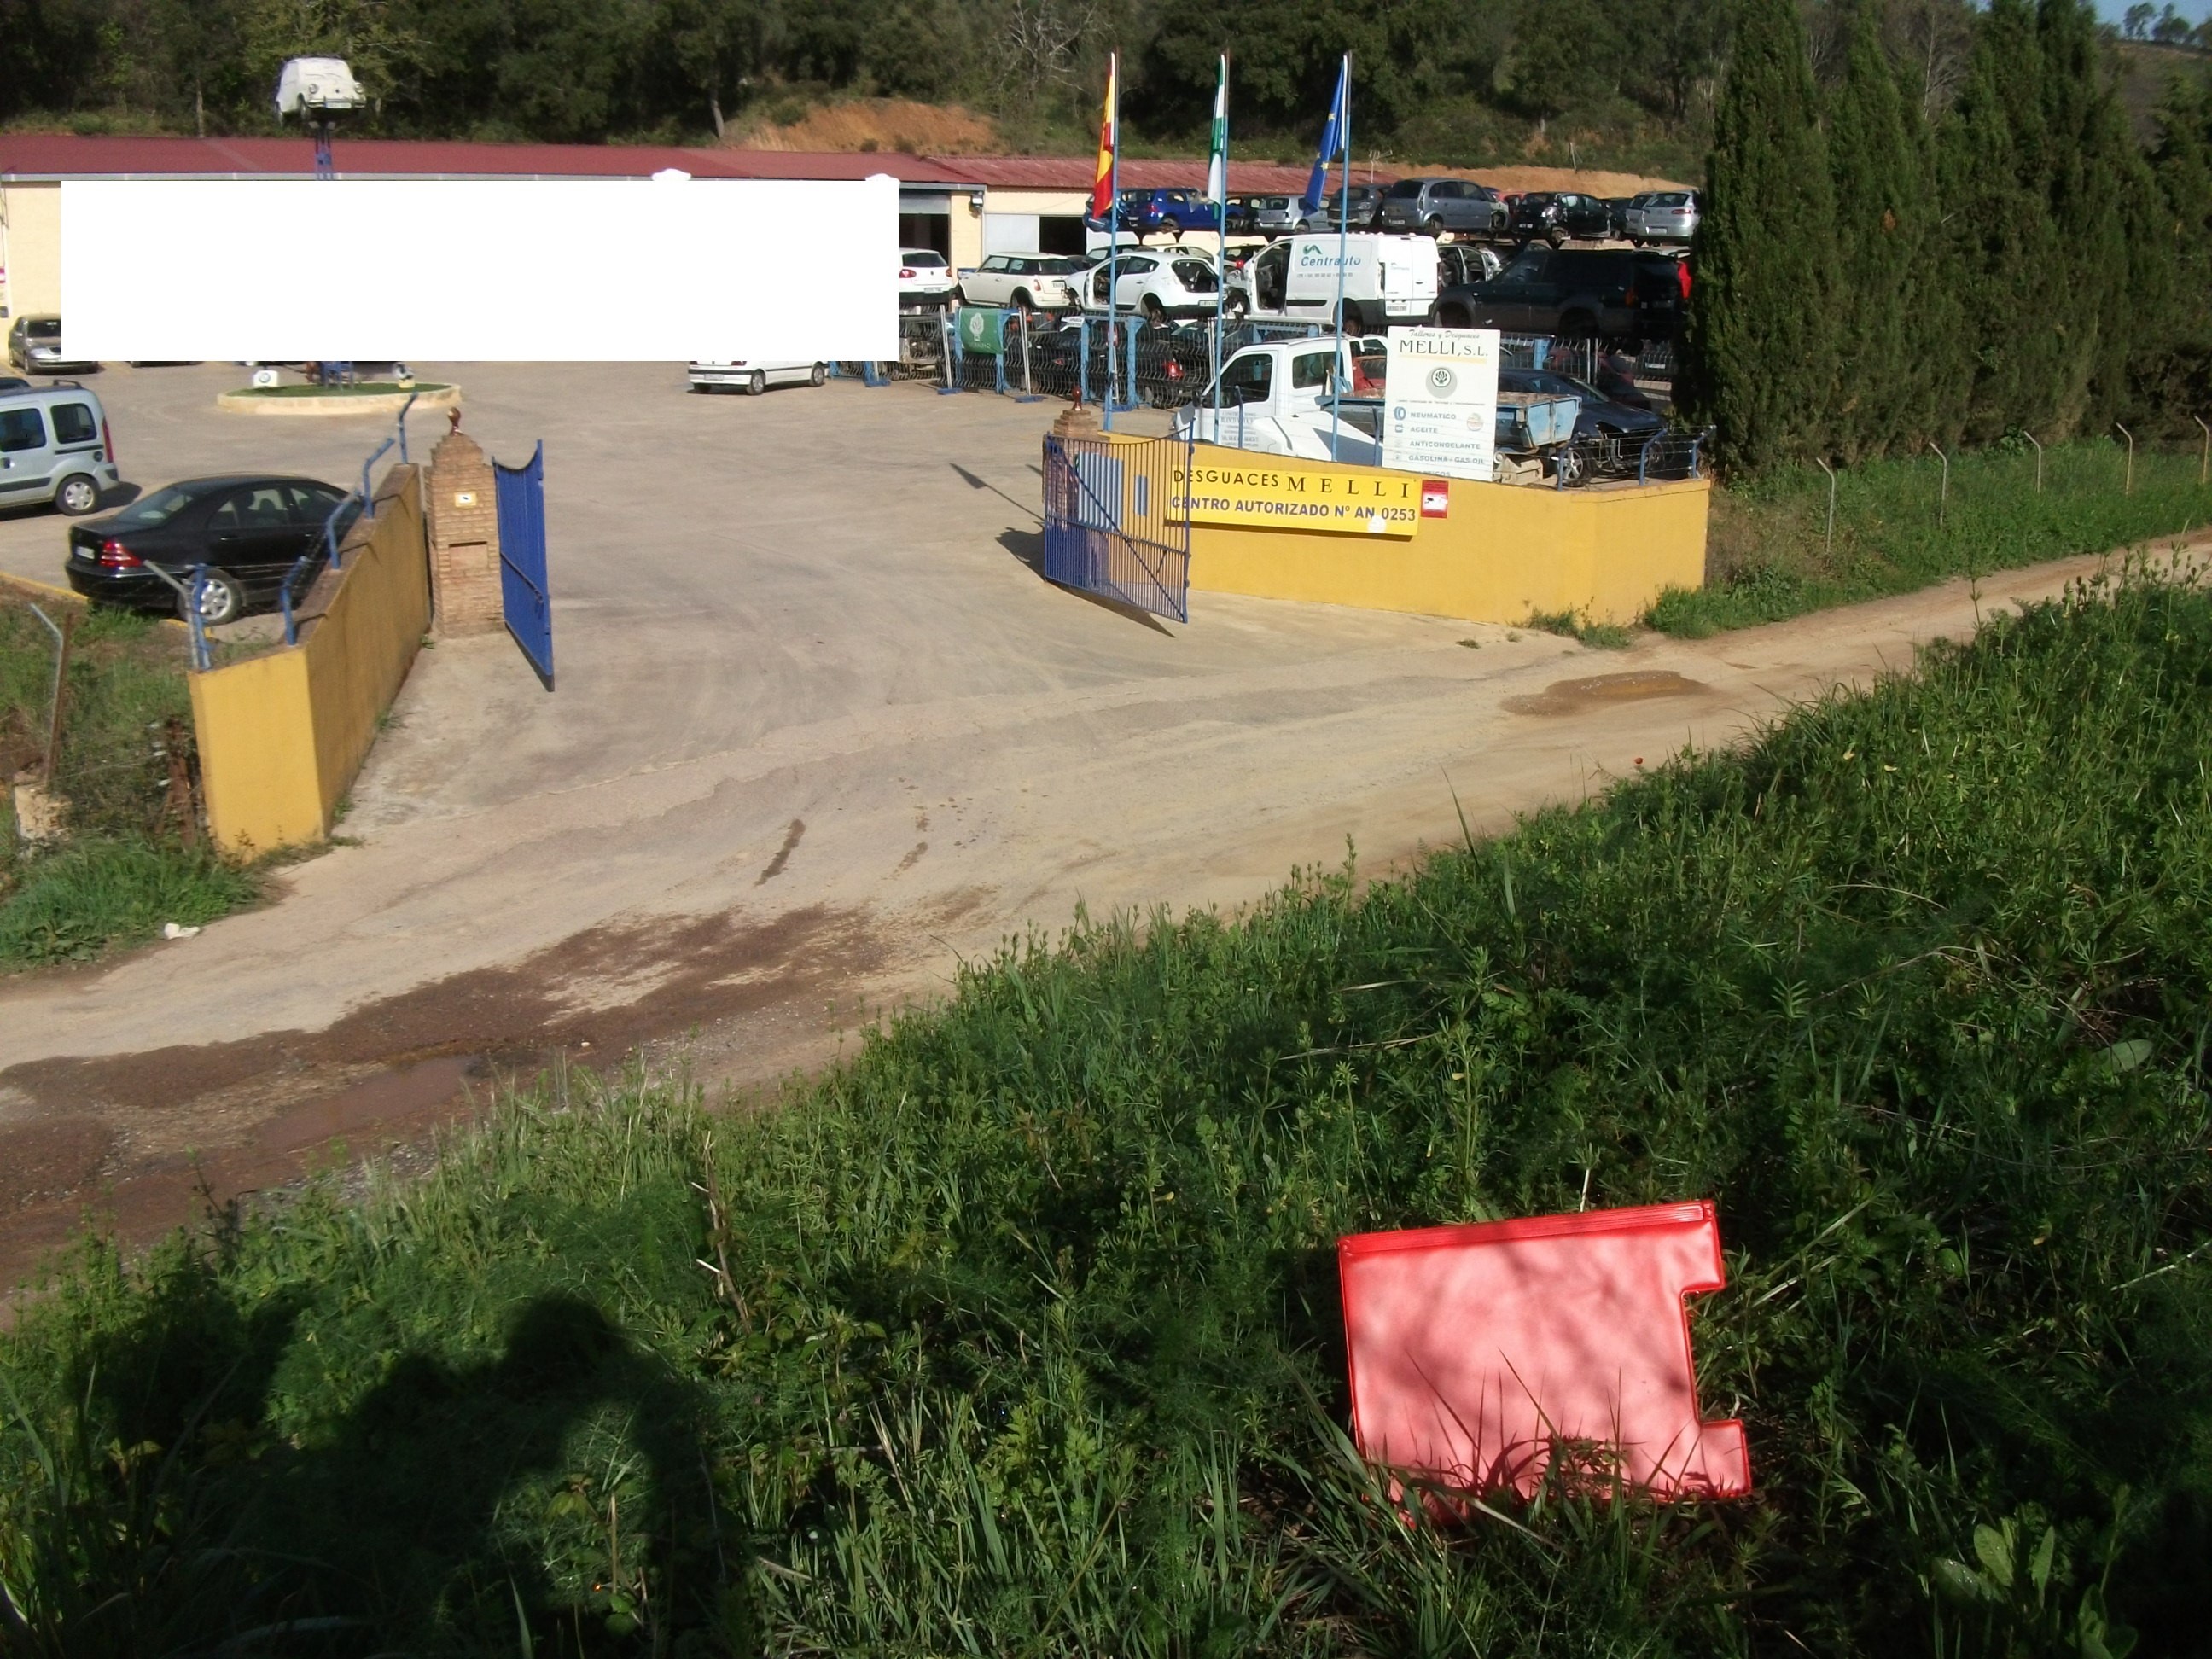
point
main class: Grassland
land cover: Spontaneously vegetated surfaces
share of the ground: 50 - 75 %
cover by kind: herbaceous plants 95 %, shrubs 5 %
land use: Abandoned areas
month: April
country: ES
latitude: 37.9228
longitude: -6.6895
